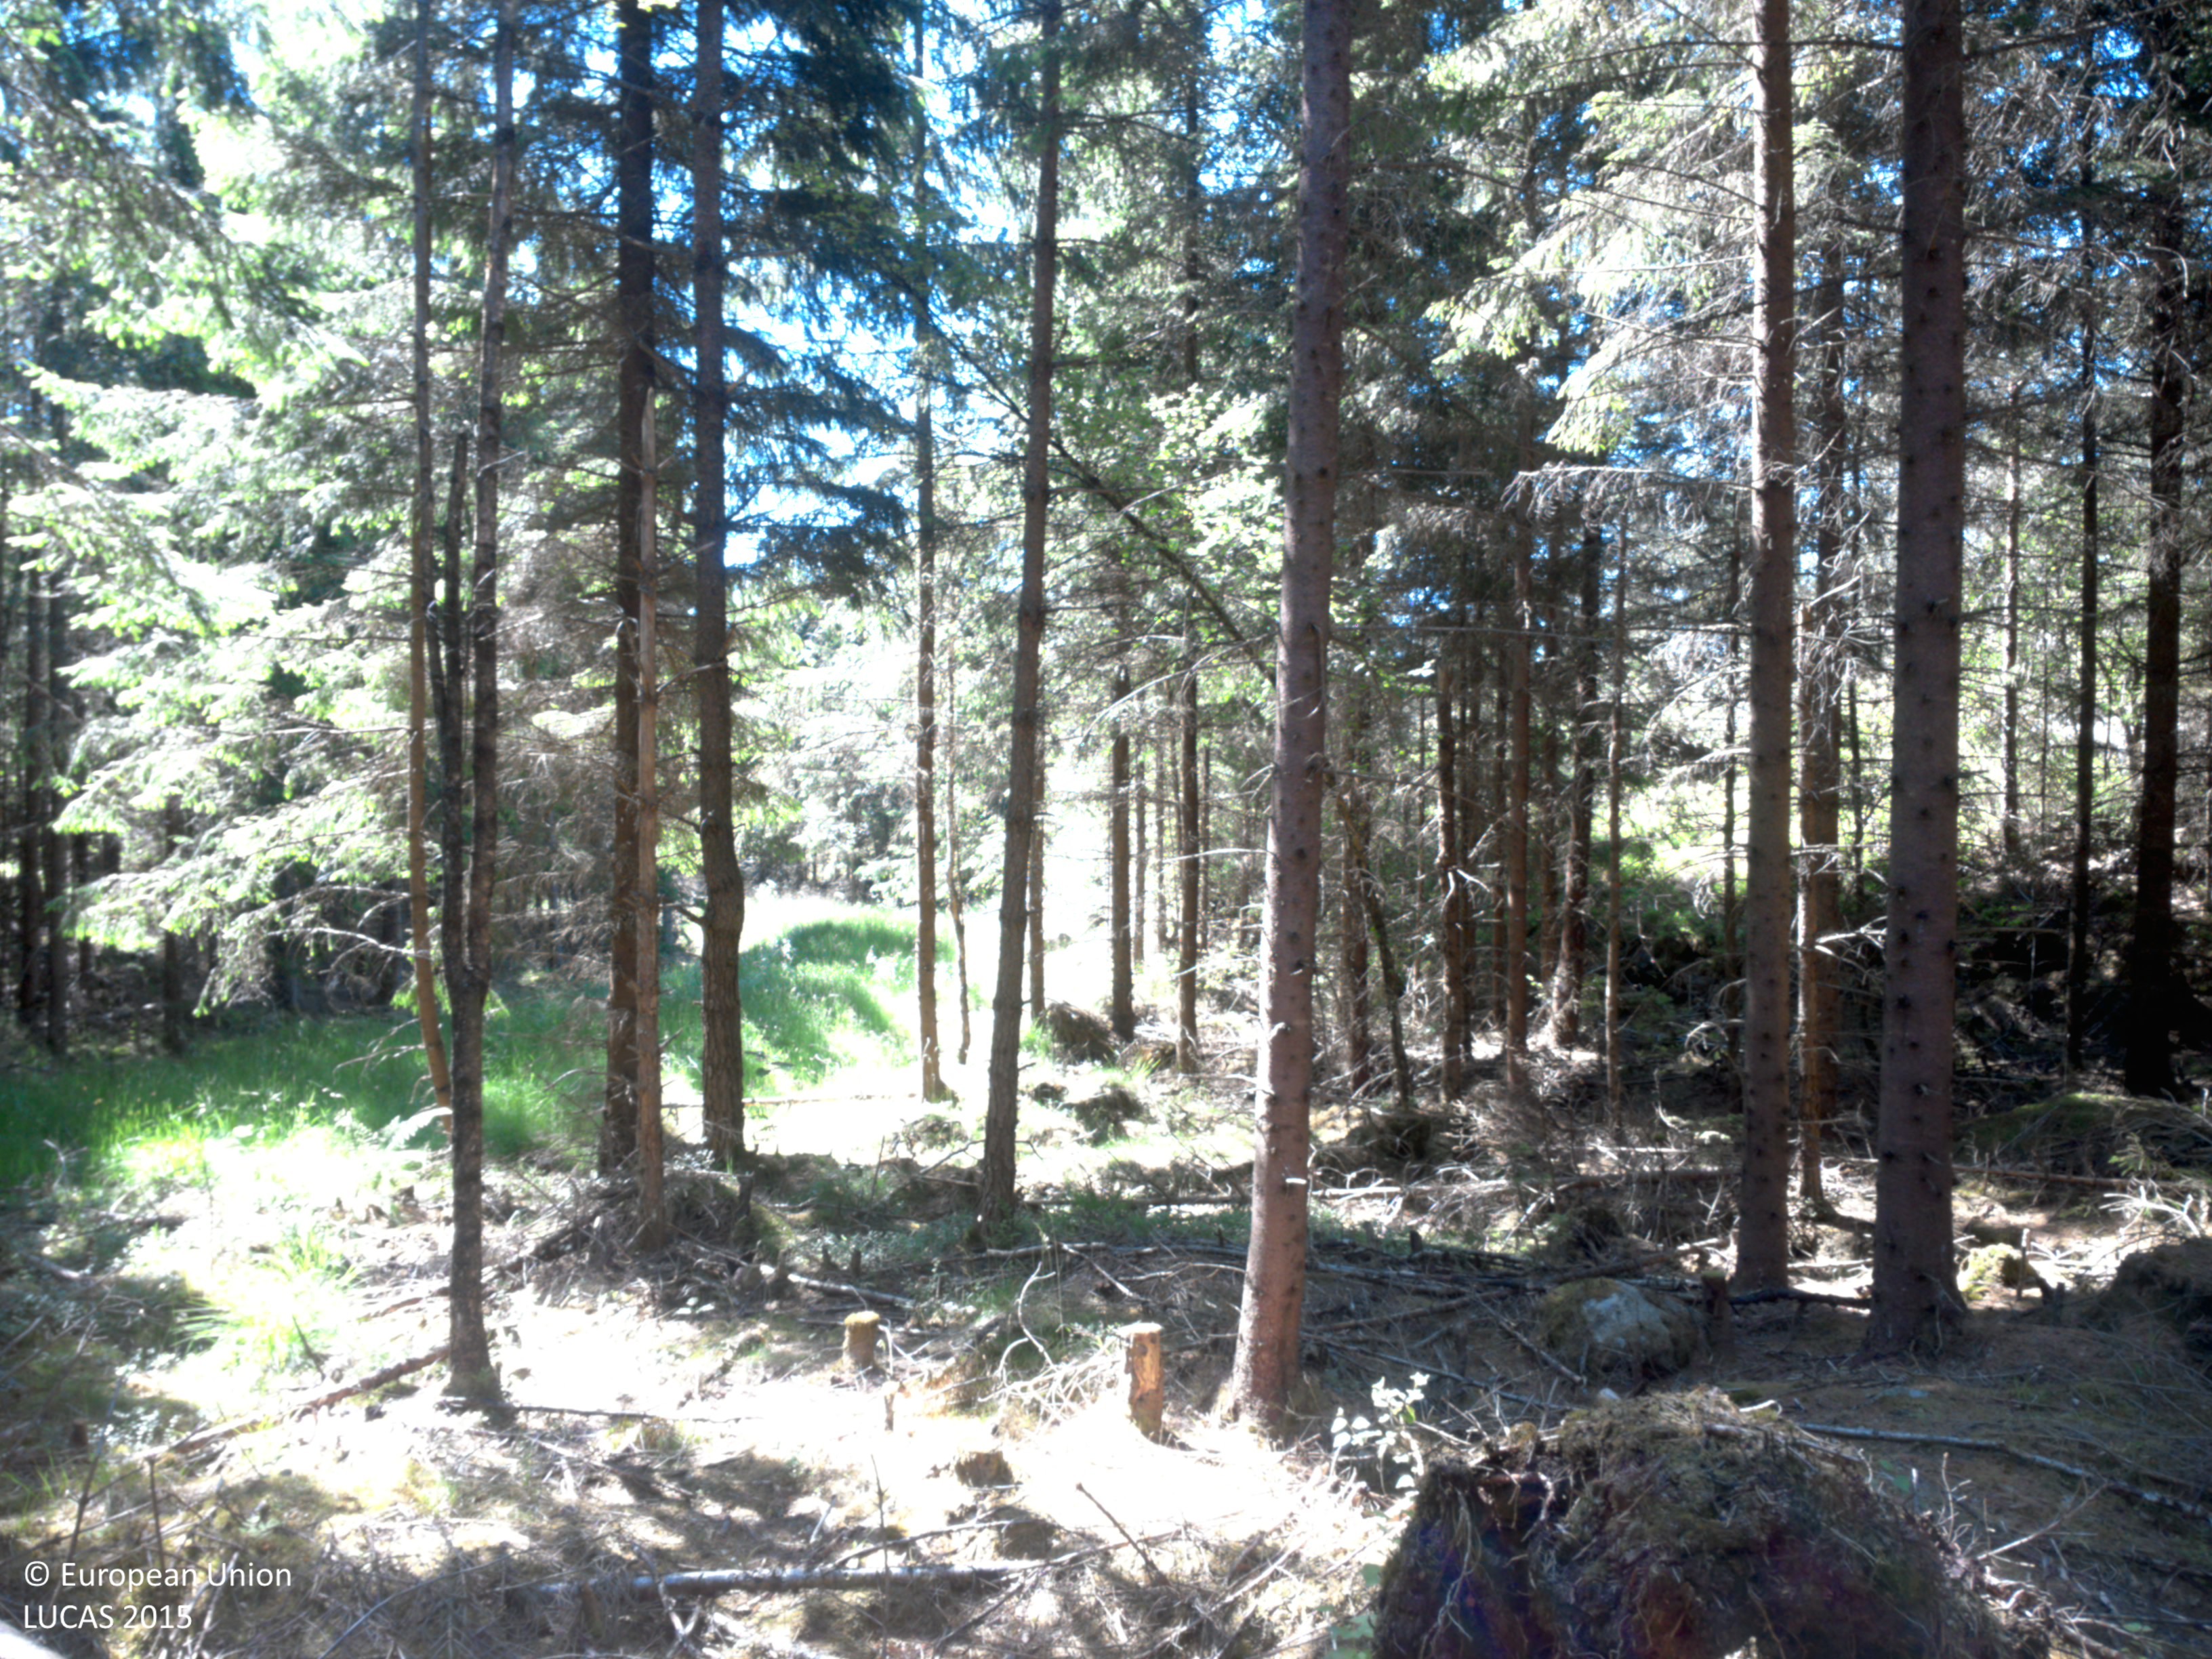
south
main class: Woodland
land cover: Other coniferous woodland
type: boreal forest
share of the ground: 50 - 75 %
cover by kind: coniferous forest trees 50 %, herbaceous plants 30 %, lichens and mosses 10 %, broadleaved forest trees 5 %, shrubs 5 %
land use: Forestry
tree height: > 5 m
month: July
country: SE
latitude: 58.5124
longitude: 11.8671
